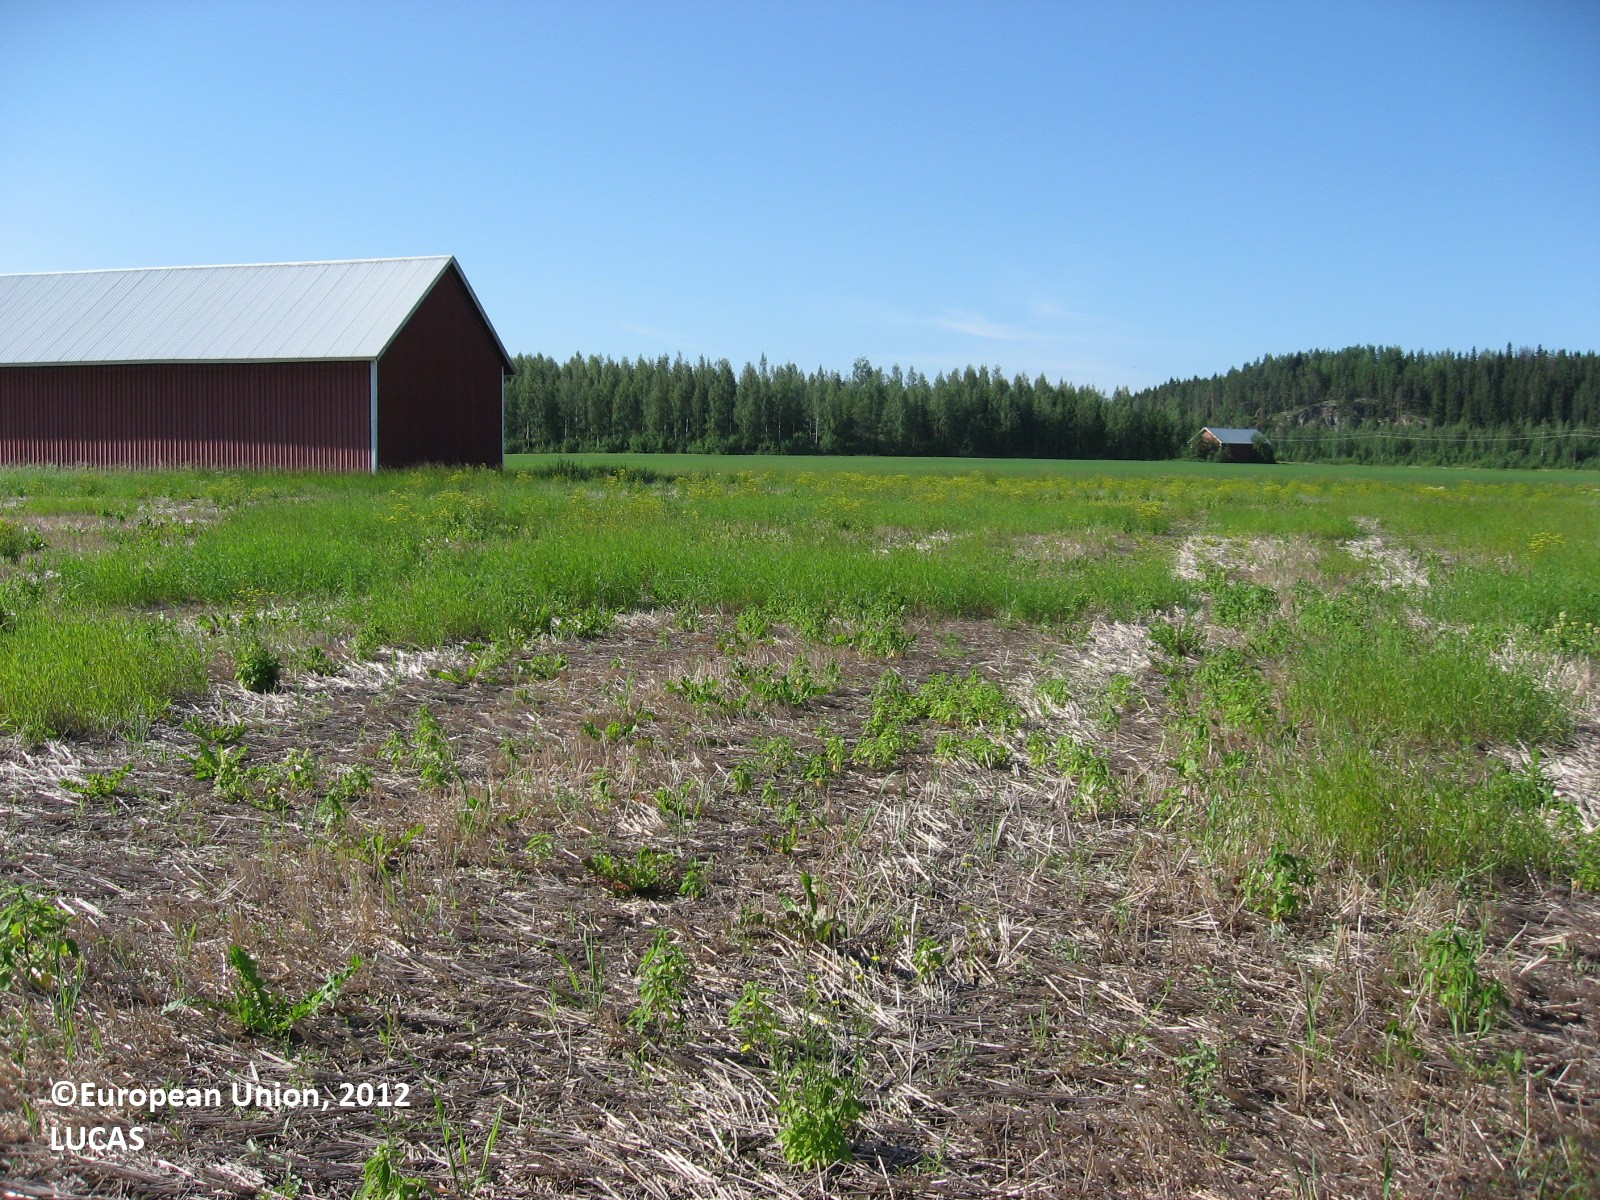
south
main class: Grassland
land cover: Spontaneously vegetated surfaces
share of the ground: 50 - 75 %
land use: Fallow land
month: July
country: FI
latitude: 60.8478
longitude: 26.2865
